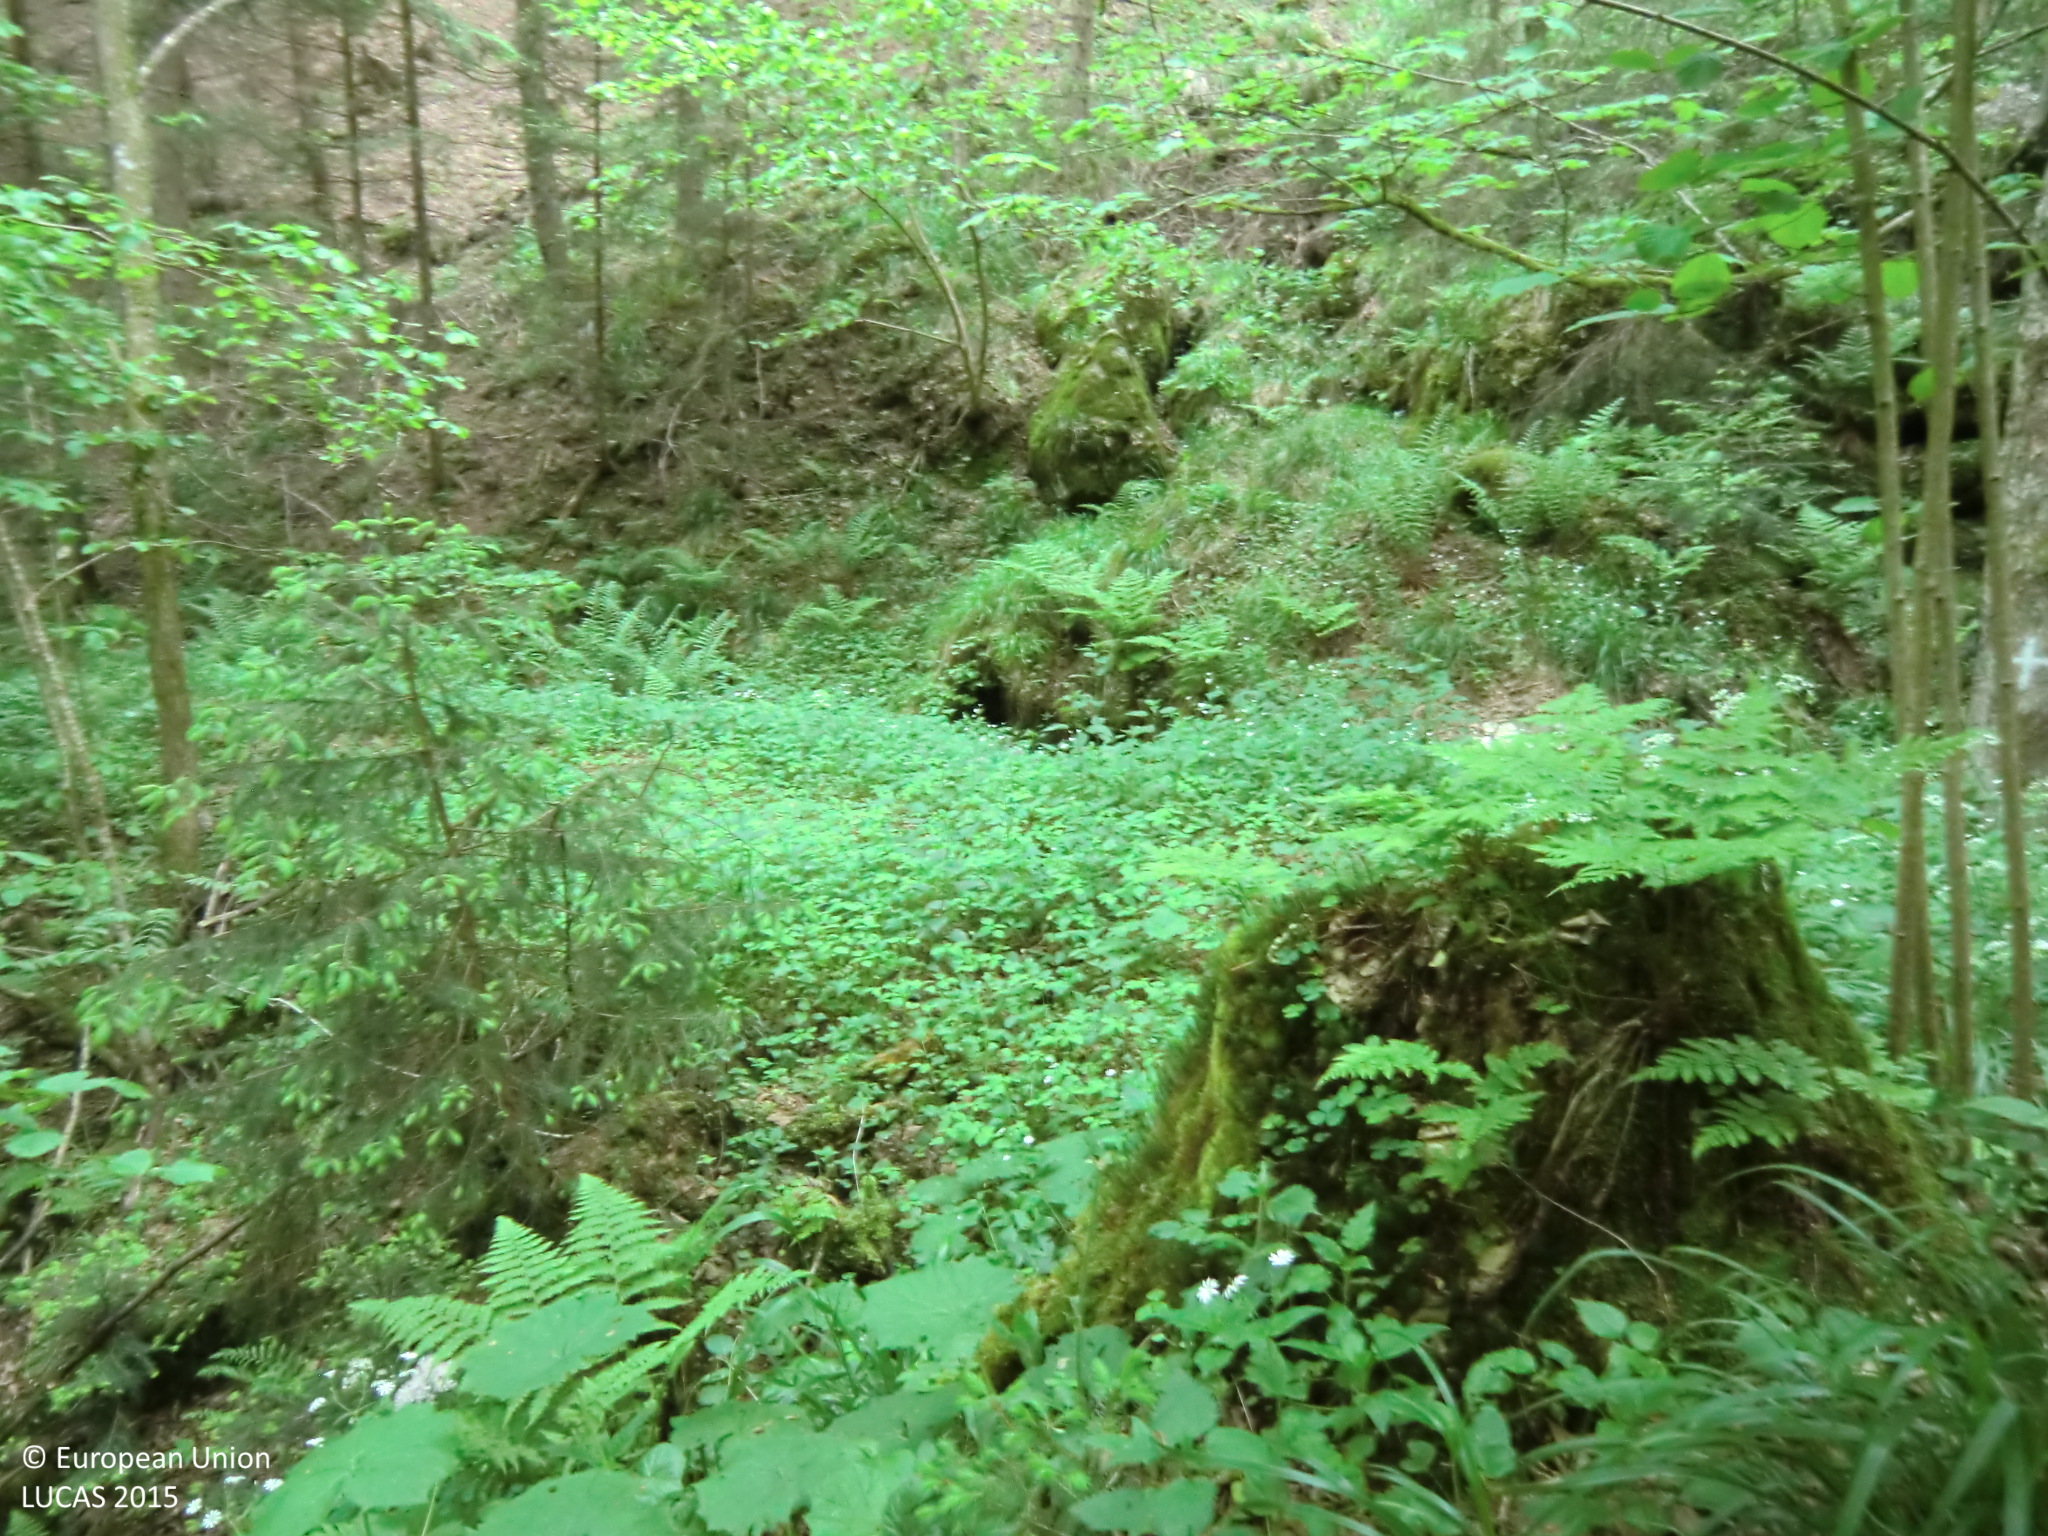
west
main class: Woodland
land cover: Spruce dominated mixed woodland
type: hemiboreal forest and nemoral coniferous forest and mixed broadleaved-coniferous forest
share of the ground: > 75 %
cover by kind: coniferous forest trees 40 %, broadleaved forest trees 40 %, shrubs 10 %, herbaceous plants 10 %
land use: Forestry
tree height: > 5 m
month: May
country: AT
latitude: 48.3646
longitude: 14.9550
